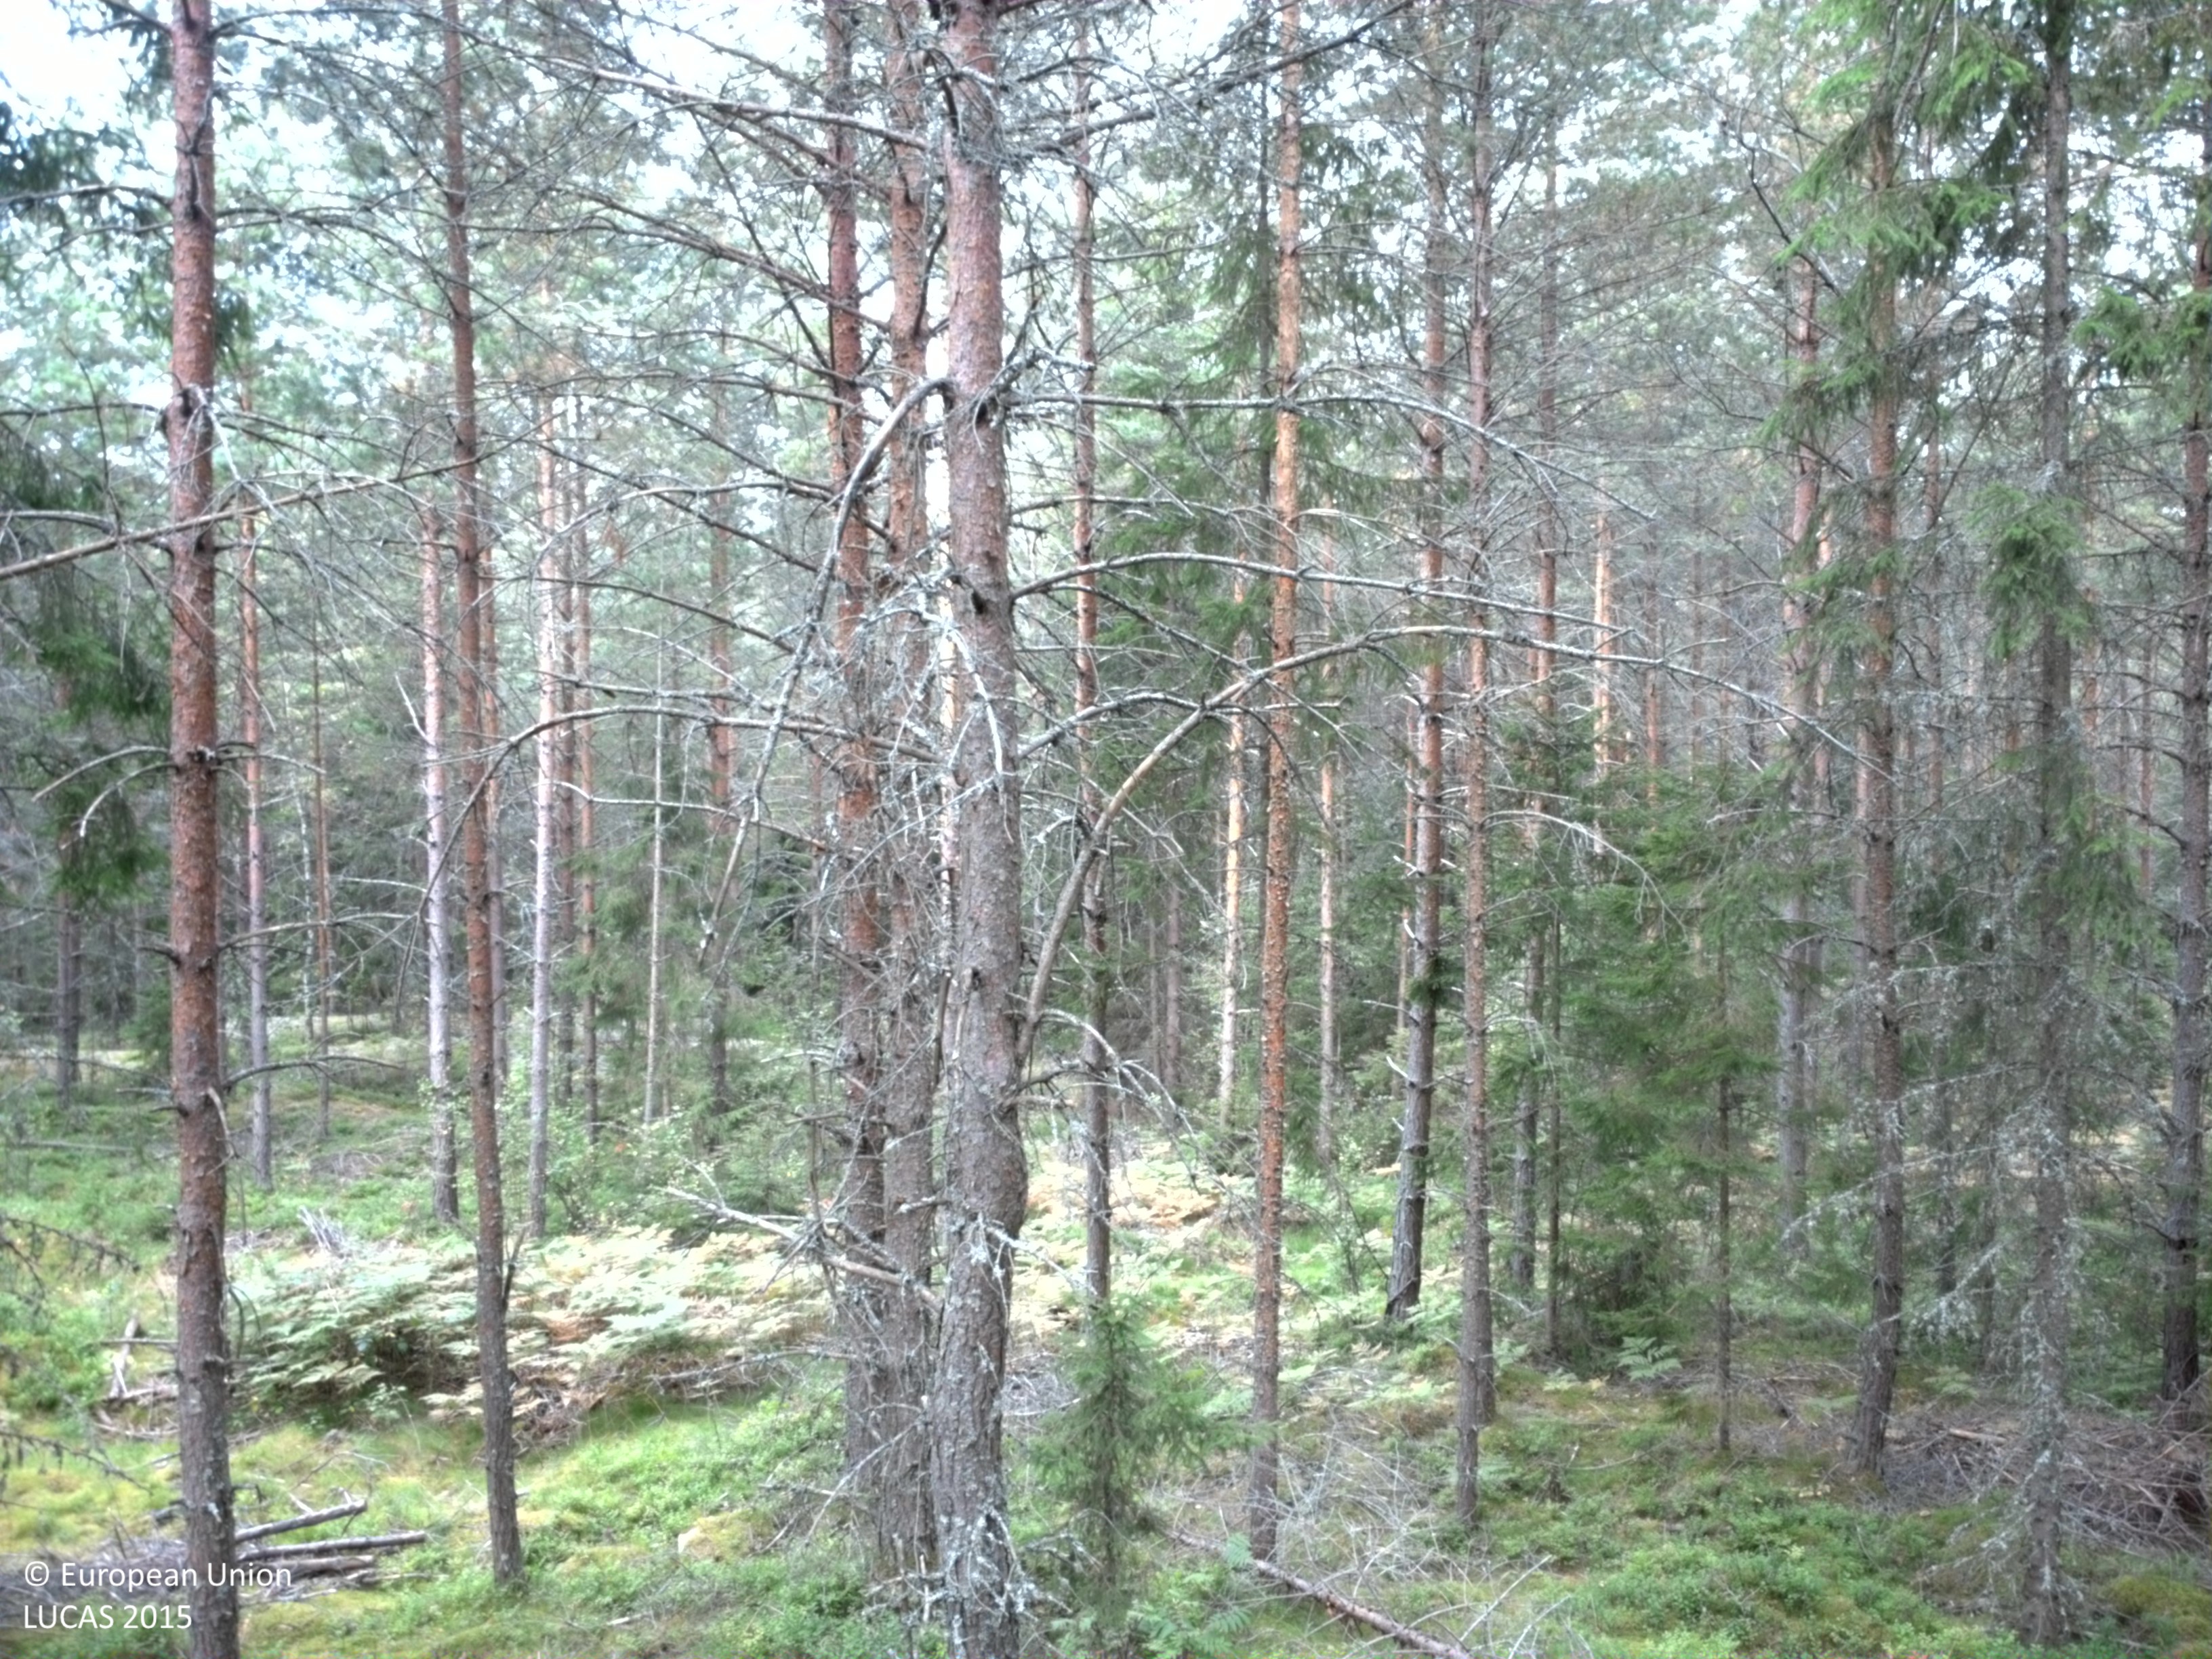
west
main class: Woodland
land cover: Pine dominated coniferous woodland
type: boreal forest
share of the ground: 50 - 75 %
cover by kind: coniferous forest trees 70 %, shrubs 20 %, lichens and mosses 10 %
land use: Forestry
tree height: > 5 m
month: August
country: SE
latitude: 59.6331
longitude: 13.4853
